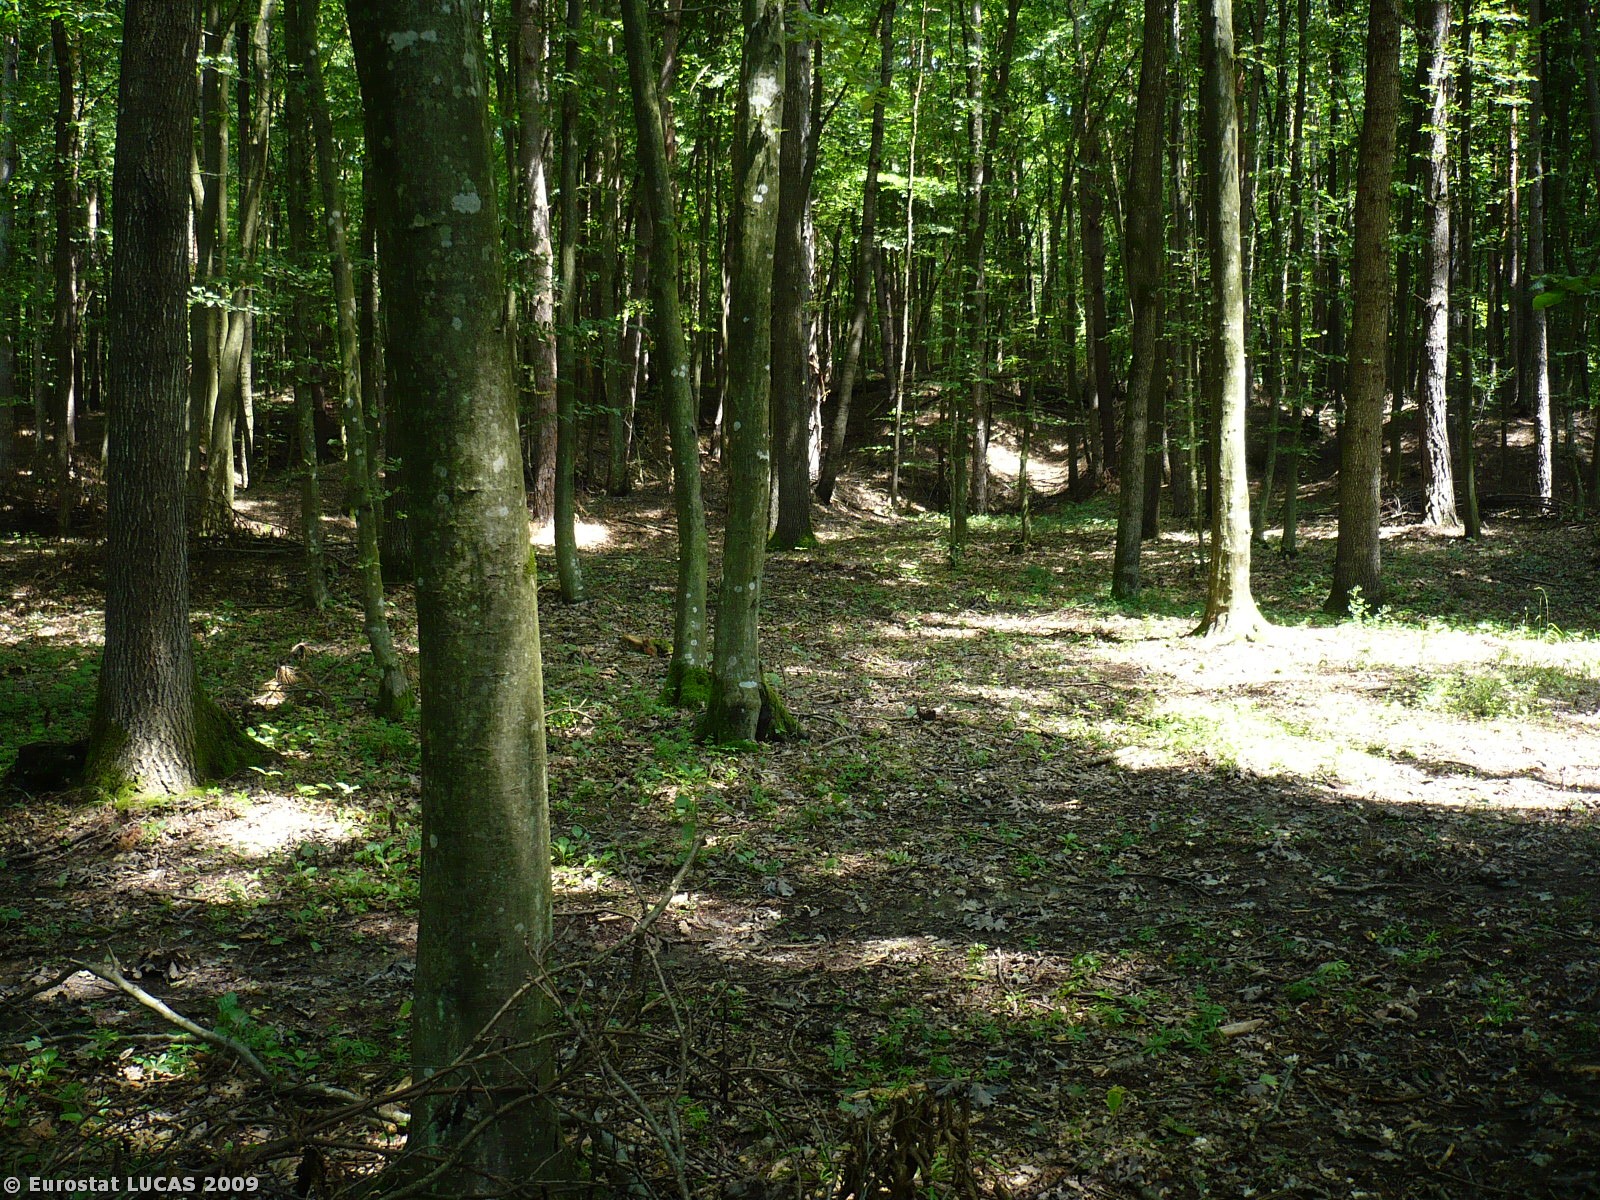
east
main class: Woodland
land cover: Broadleaved woodland
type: mesophytic deciduous forest
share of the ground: > 75 %
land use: Forestry
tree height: > 5 m
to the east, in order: Broadleaved woodland; Tracks; Broadleaved woodland; Rivers and streams; Mixed woodland
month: July
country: SI
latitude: 46.6688
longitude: 16.3404
